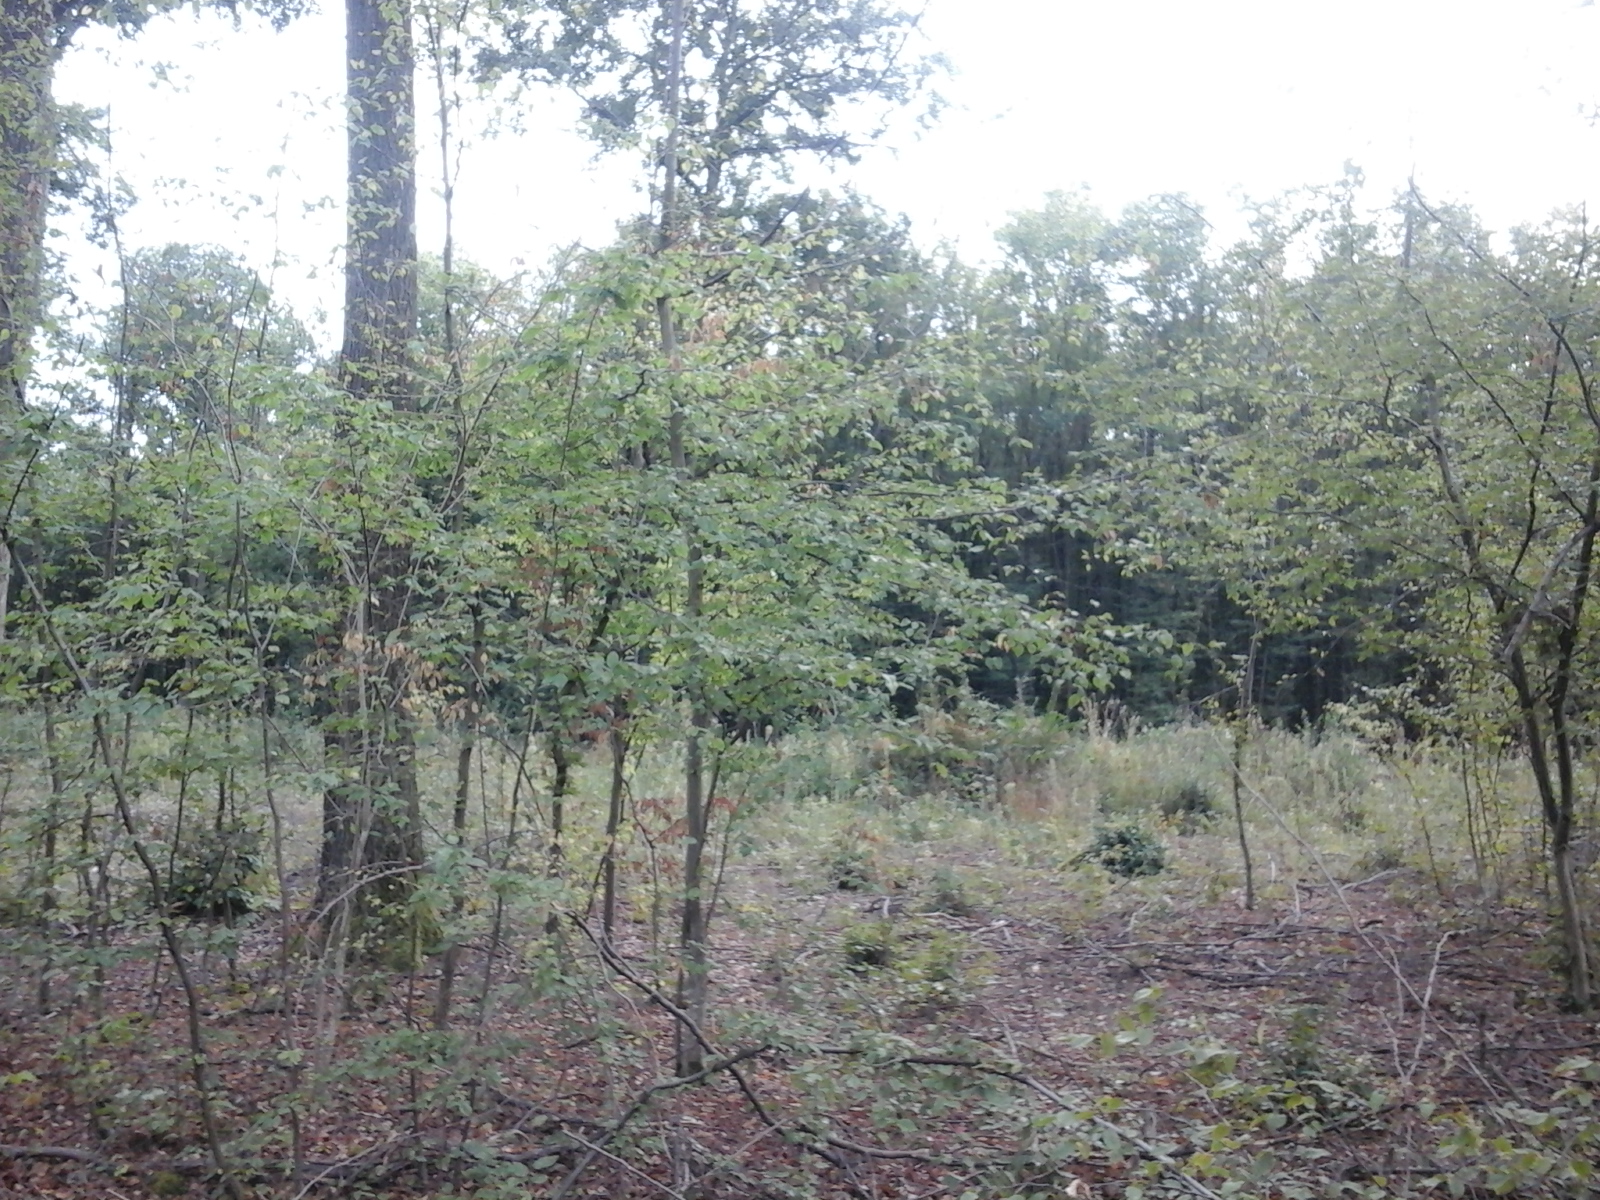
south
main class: Woodland
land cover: Broadleaved woodland
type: beech forest
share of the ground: > 75 %
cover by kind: broadleaved forest trees 100 %
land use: Forestry
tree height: > 5 m
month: September
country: RO
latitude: 47.2697
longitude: 22.5203
